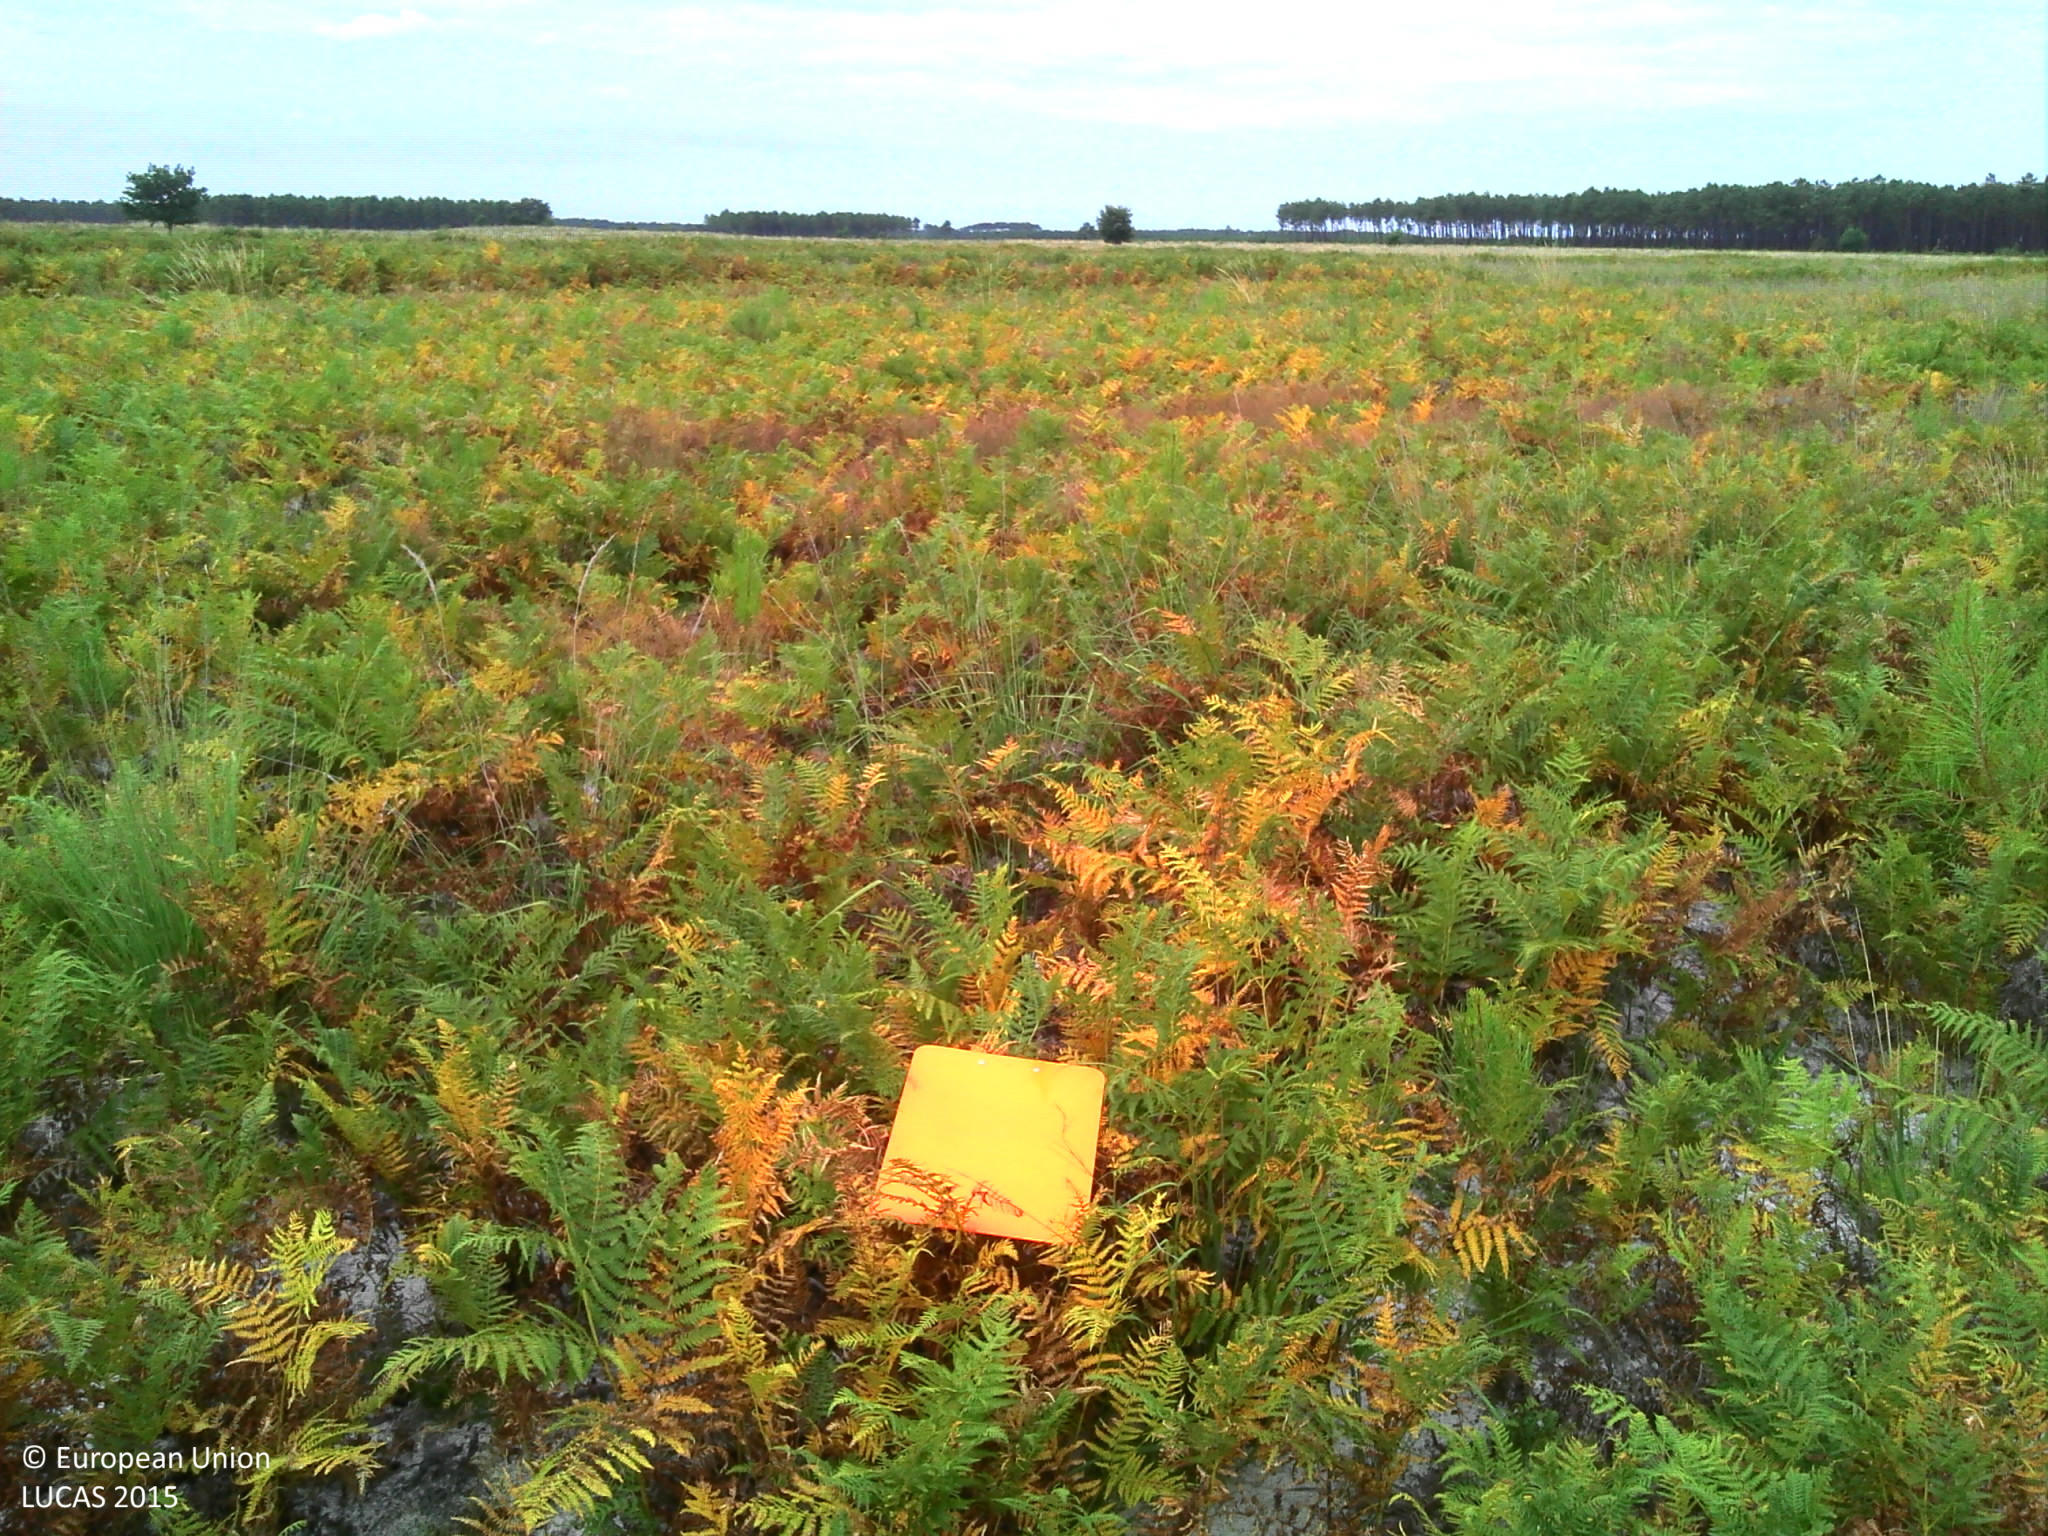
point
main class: Grassland
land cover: Spontaneously vegetated surfaces
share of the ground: > 75 %
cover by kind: herbaceous plants 95 %, shrubs 5 %
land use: Forestry
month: July
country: FR
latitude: 44.2646
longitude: -1.0809
